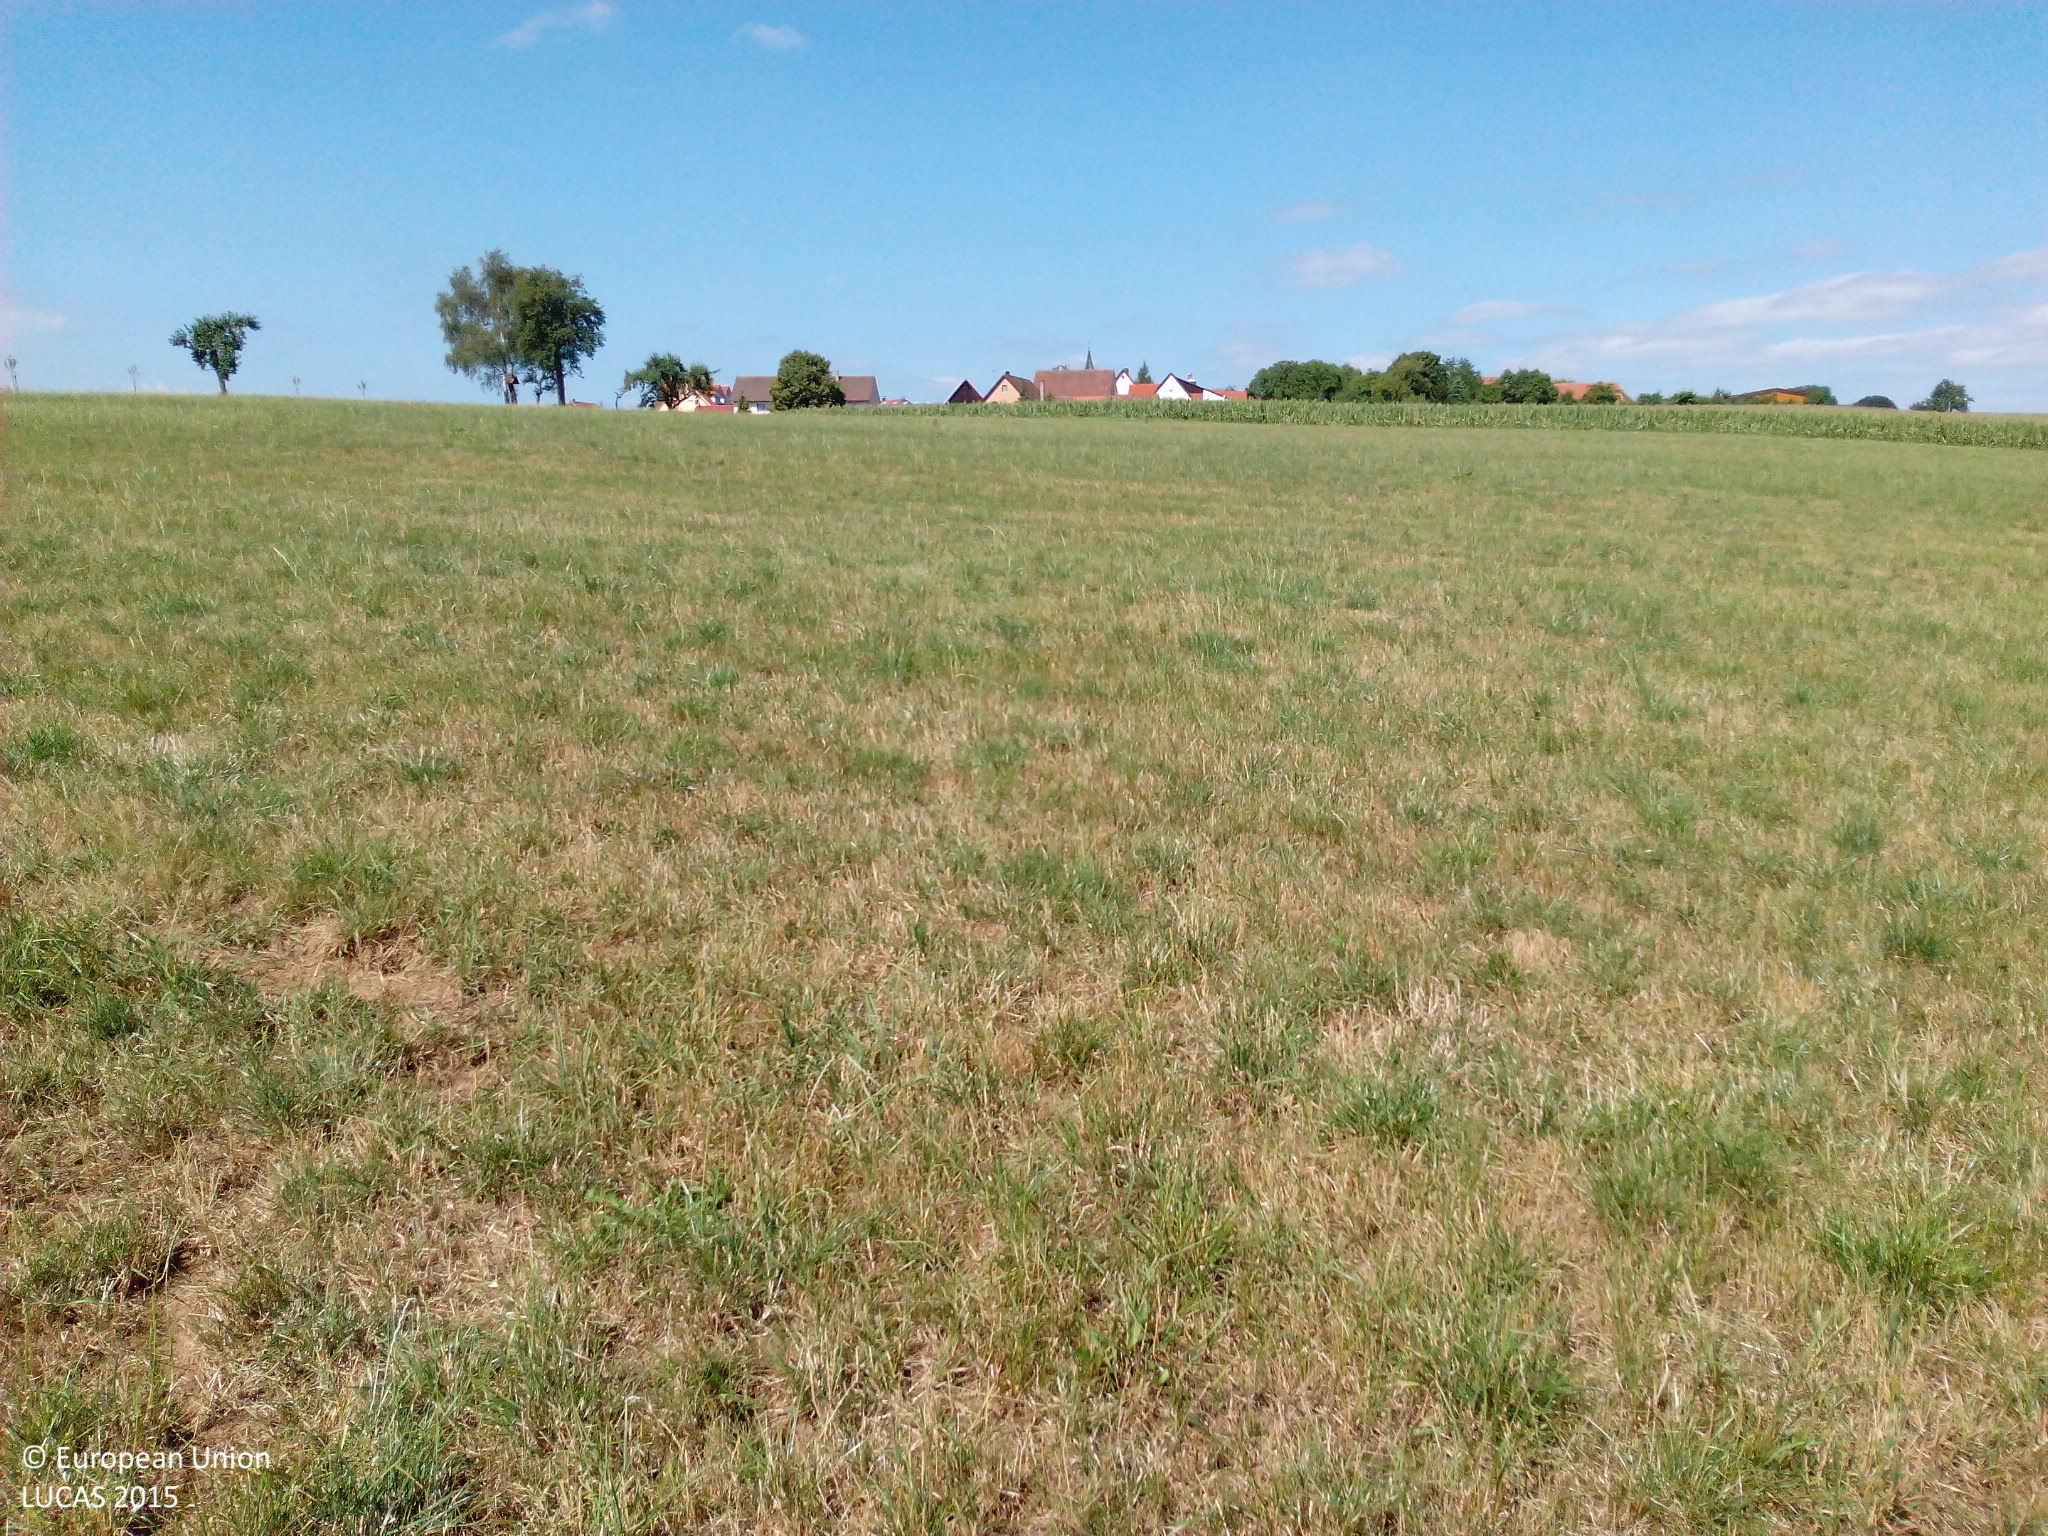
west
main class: Grassland
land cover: Grassland without tree/shrub cover
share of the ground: > 75 %
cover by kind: herbaceous plants 90 %, unconsolidated bare surface 10 %
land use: Agriculture (excluding fallow land and kitchen gardens)
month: August
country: DE
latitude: 48.9789
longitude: 10.2595
